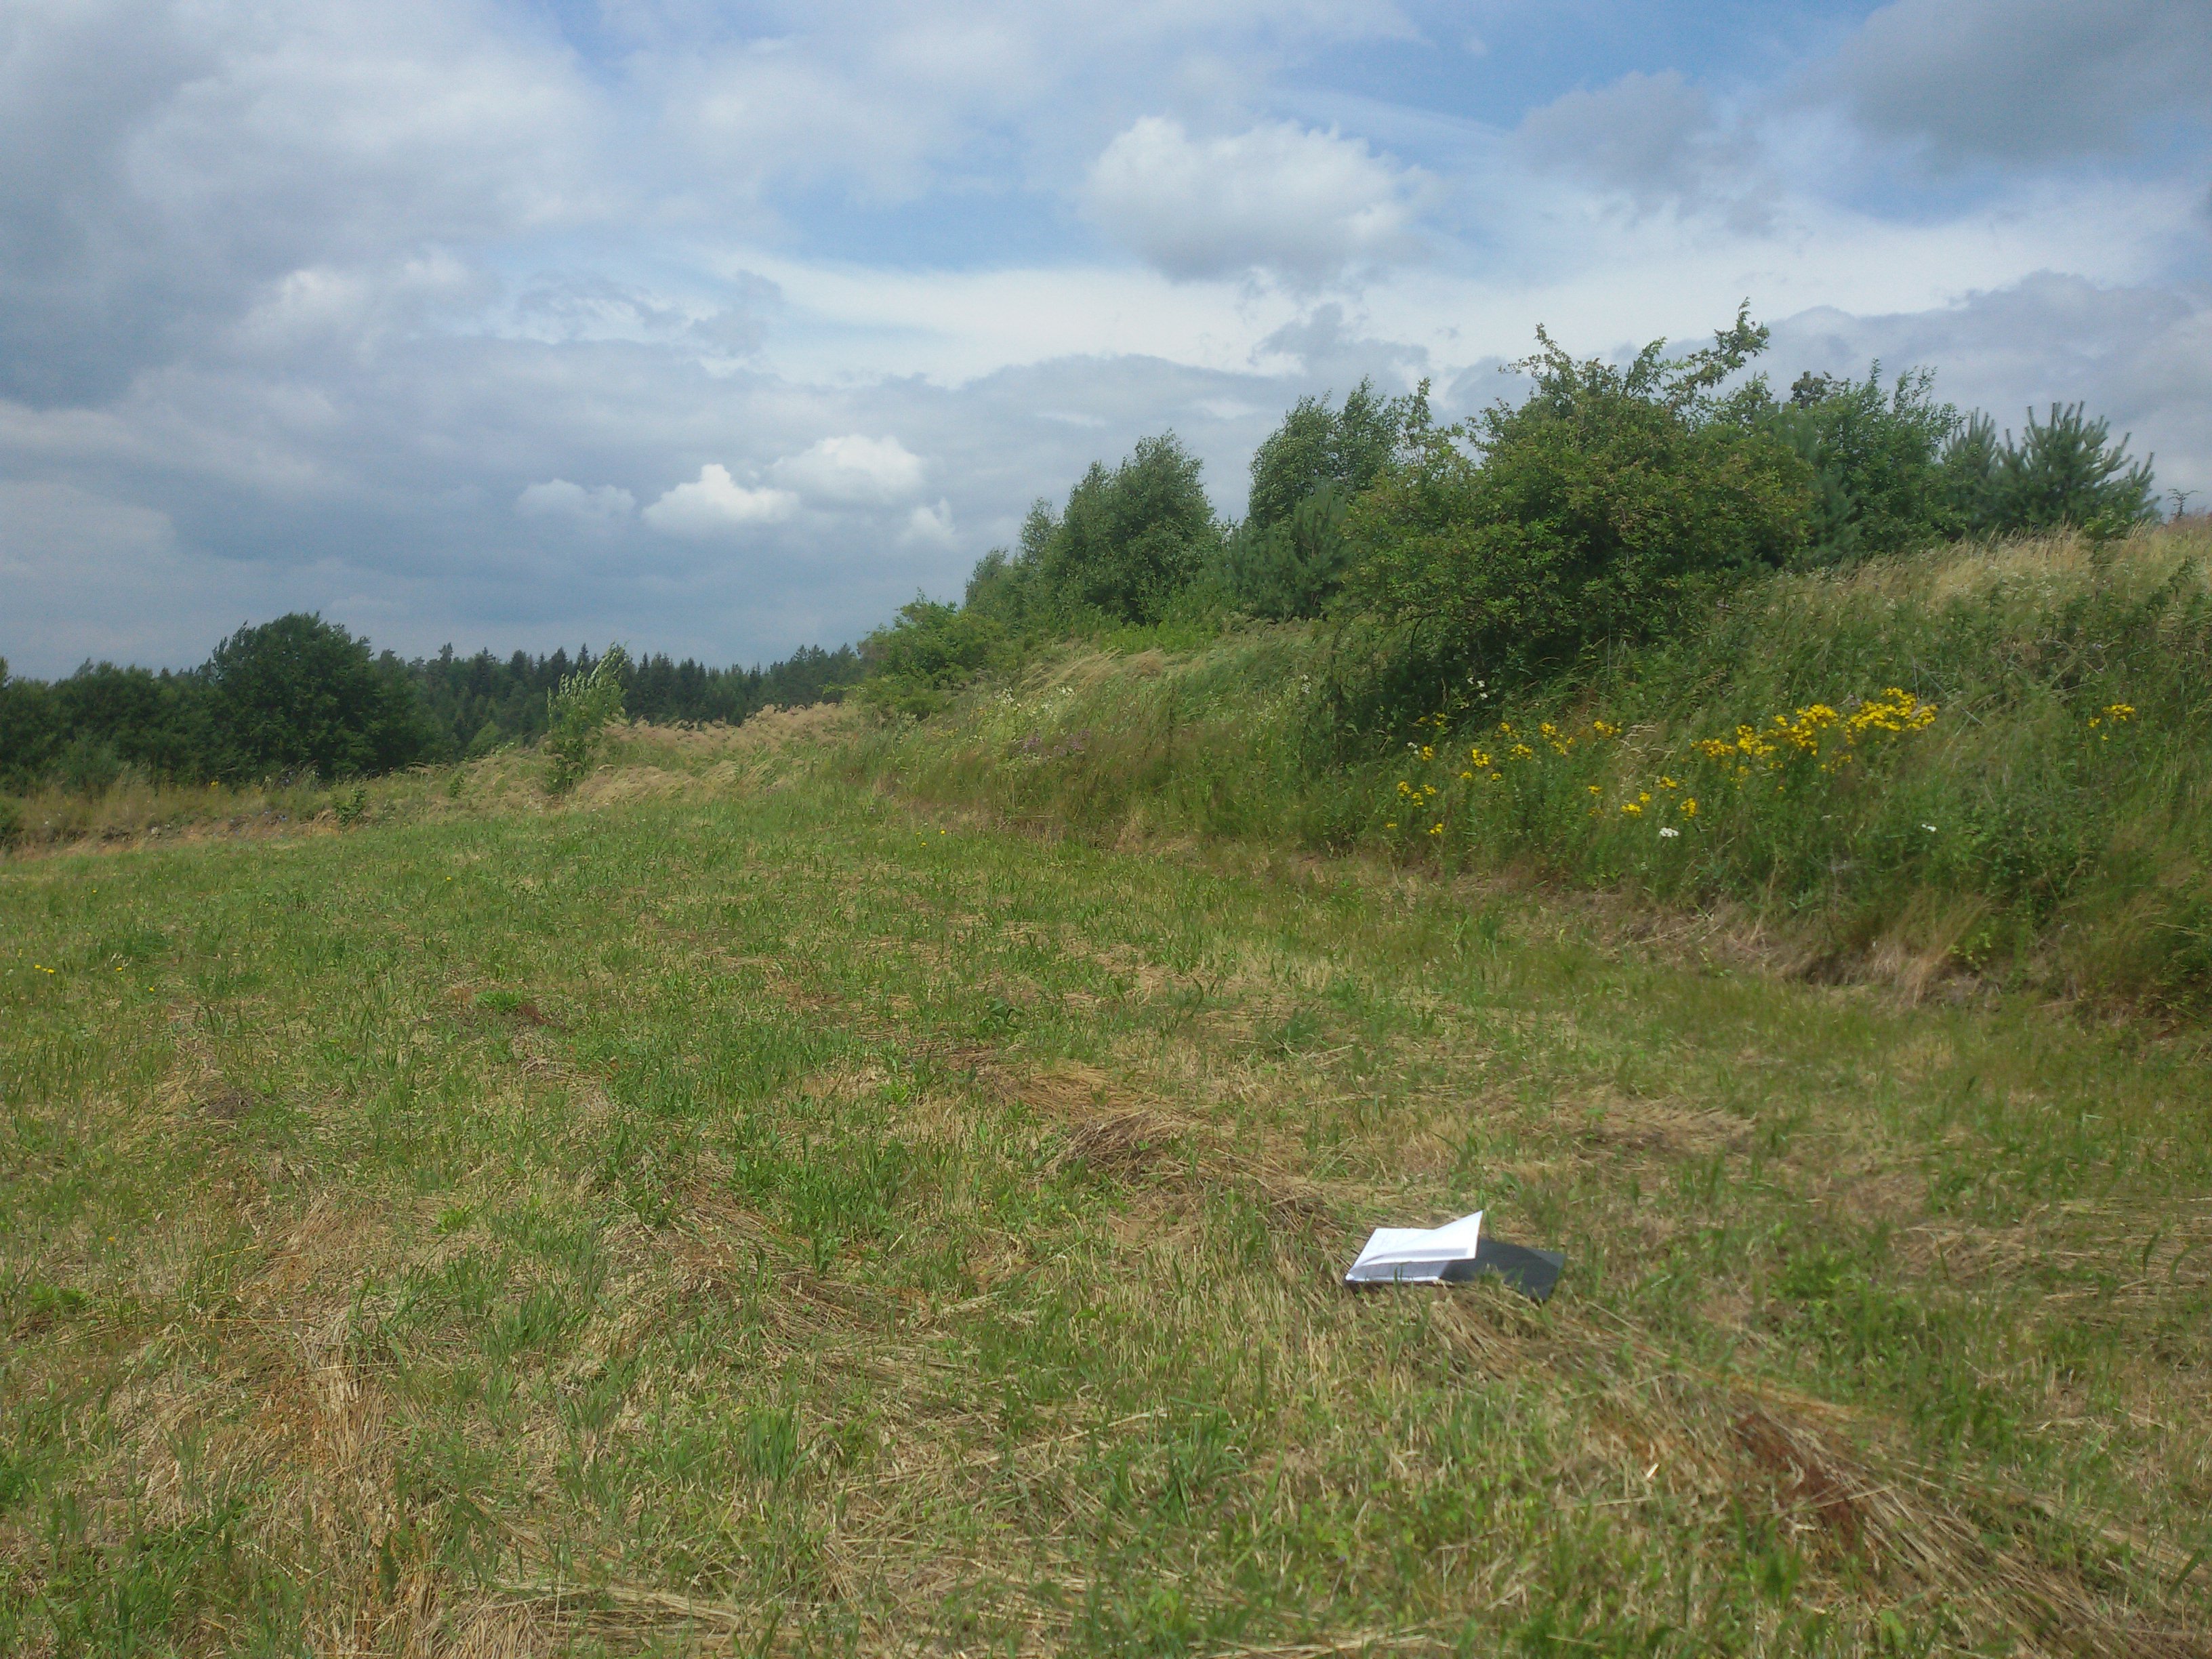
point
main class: Grassland
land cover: Grassland without tree/shrub cover
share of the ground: > 75 %
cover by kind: herbaceous plants 100 %
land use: Agriculture (excluding fallow land and kitchen gardens)
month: July
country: PL
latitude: 49.7735
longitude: 22.2667
